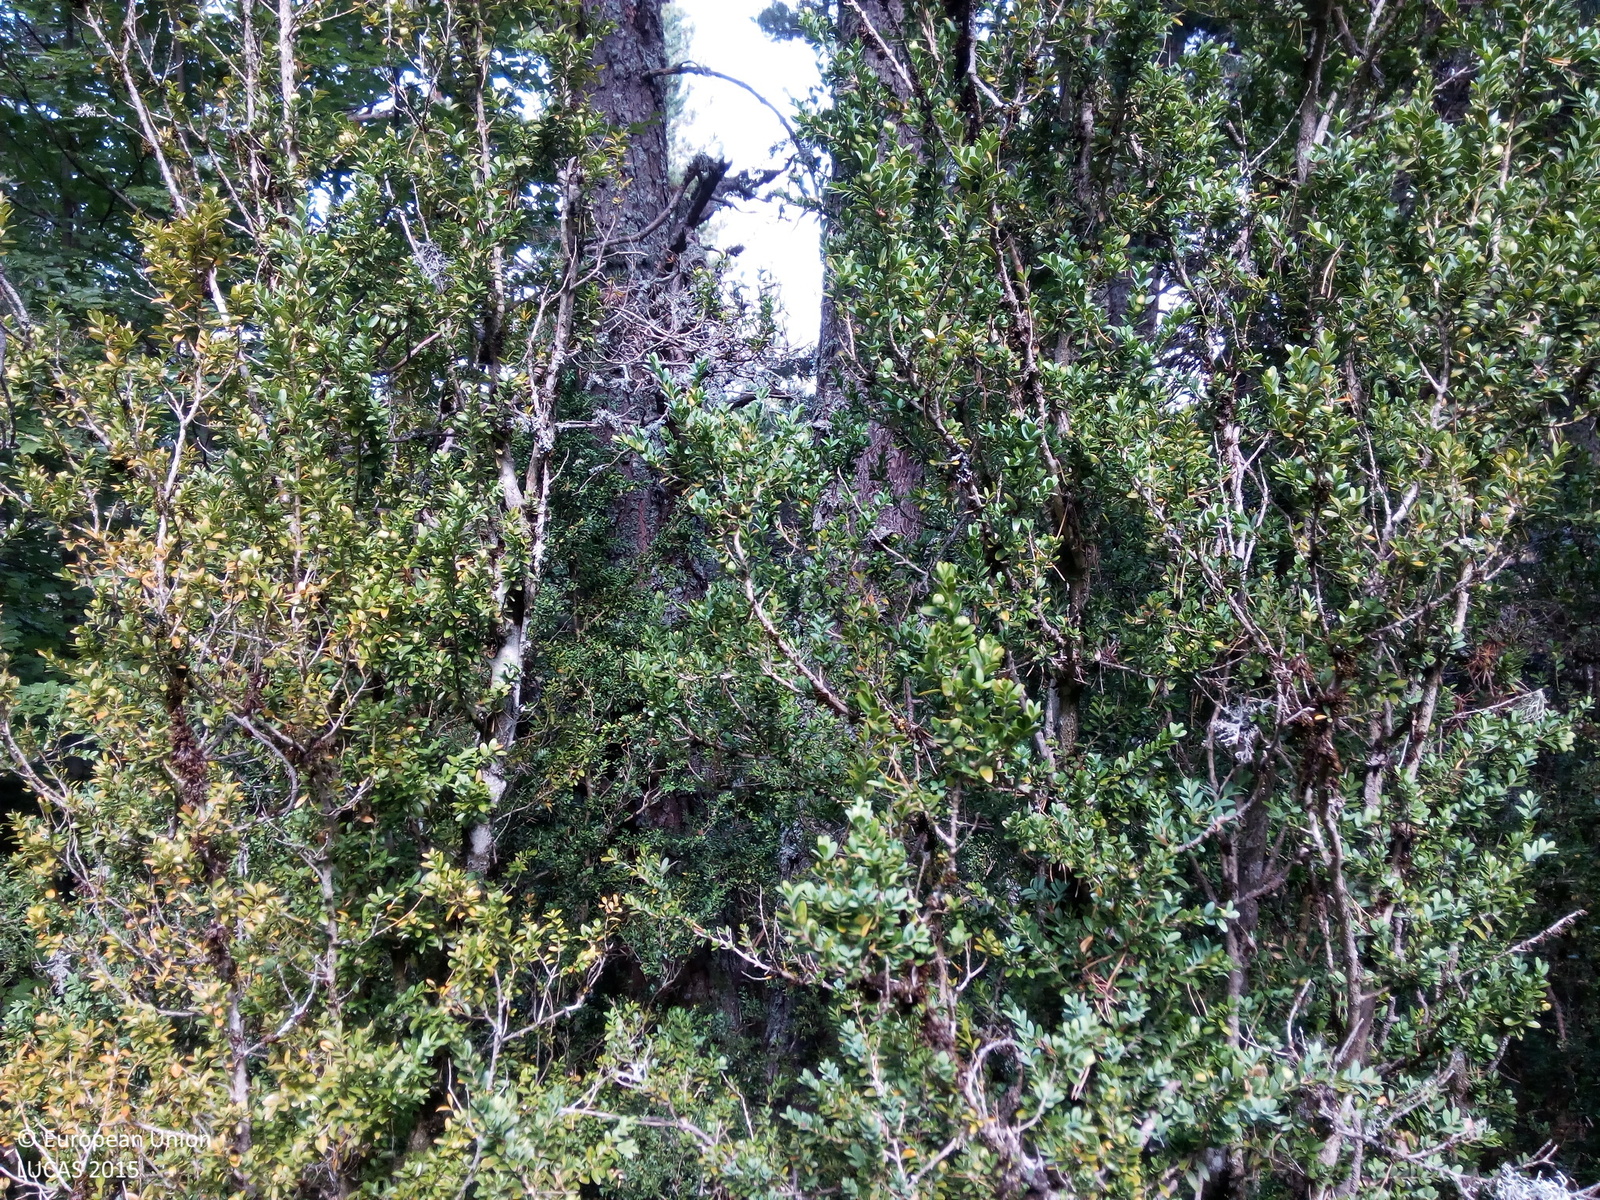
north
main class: Woodland
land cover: Pine dominated mixed woodland
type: alpine coniferous forest
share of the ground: > 75 %
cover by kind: coniferous forest trees 60 %, broadleaved forest trees 40 %
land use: Semi-natural and natural areas not in use
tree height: > 5 m
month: September
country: ES
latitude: 42.4460
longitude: 0.5341
